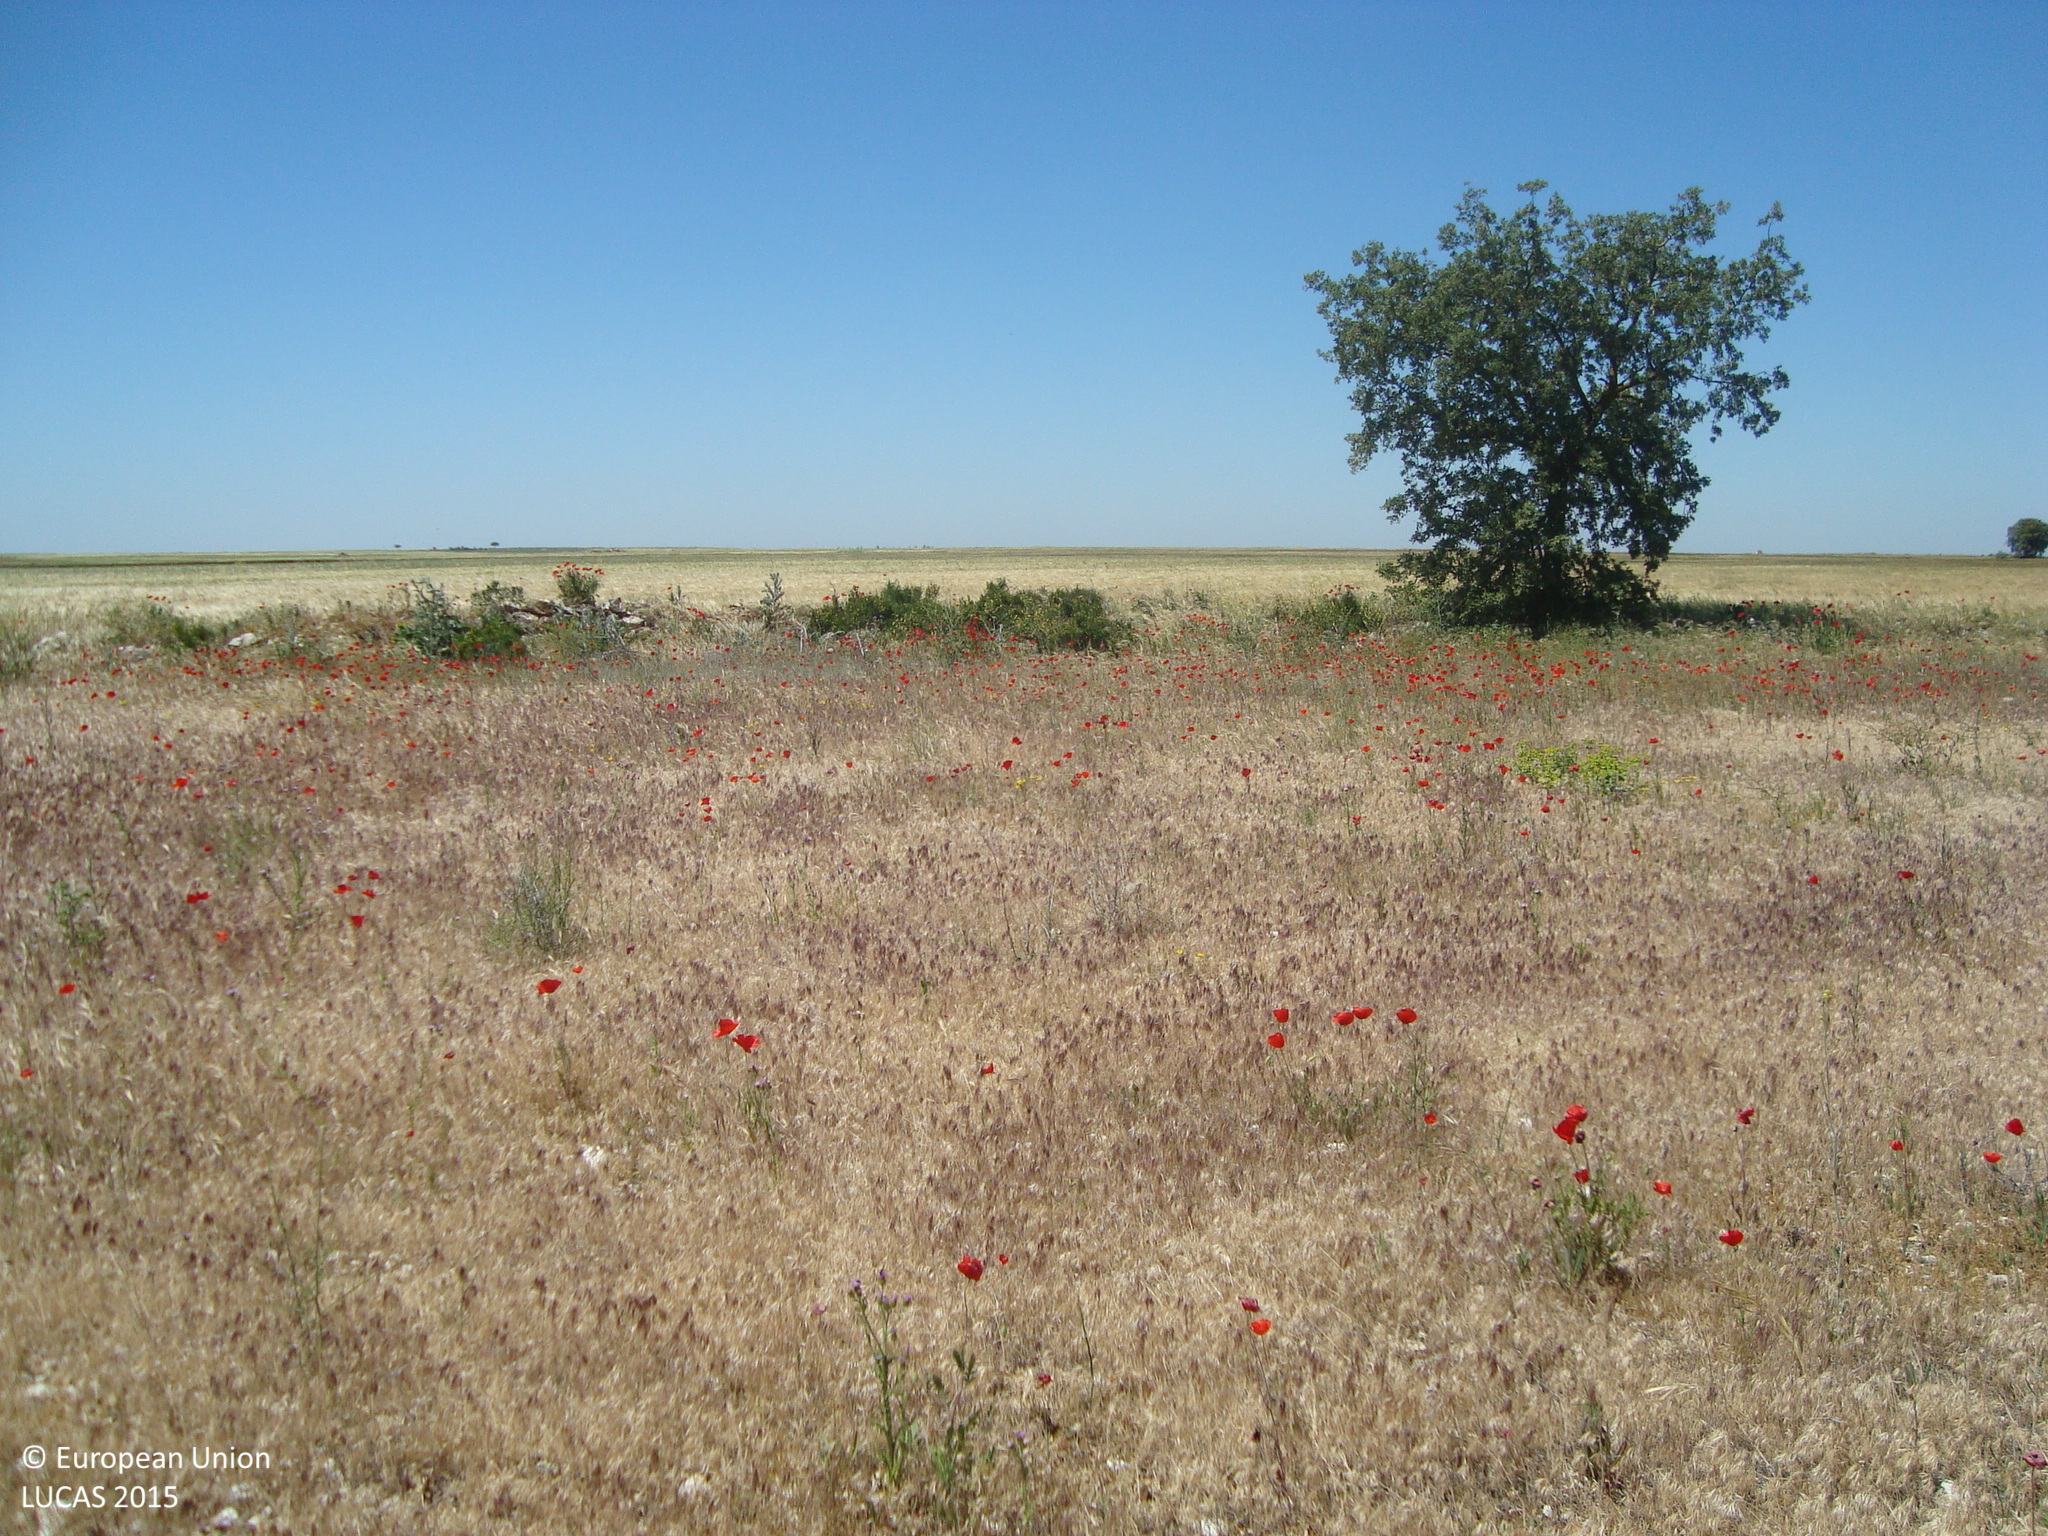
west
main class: Grassland
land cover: Spontaneously vegetated surfaces
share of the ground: > 75 %
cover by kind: herbaceous plants 90 %, unconsolidated bare surface 10 %
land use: Abandoned areas
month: May
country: ES
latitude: 41.5392
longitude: -4.1911
